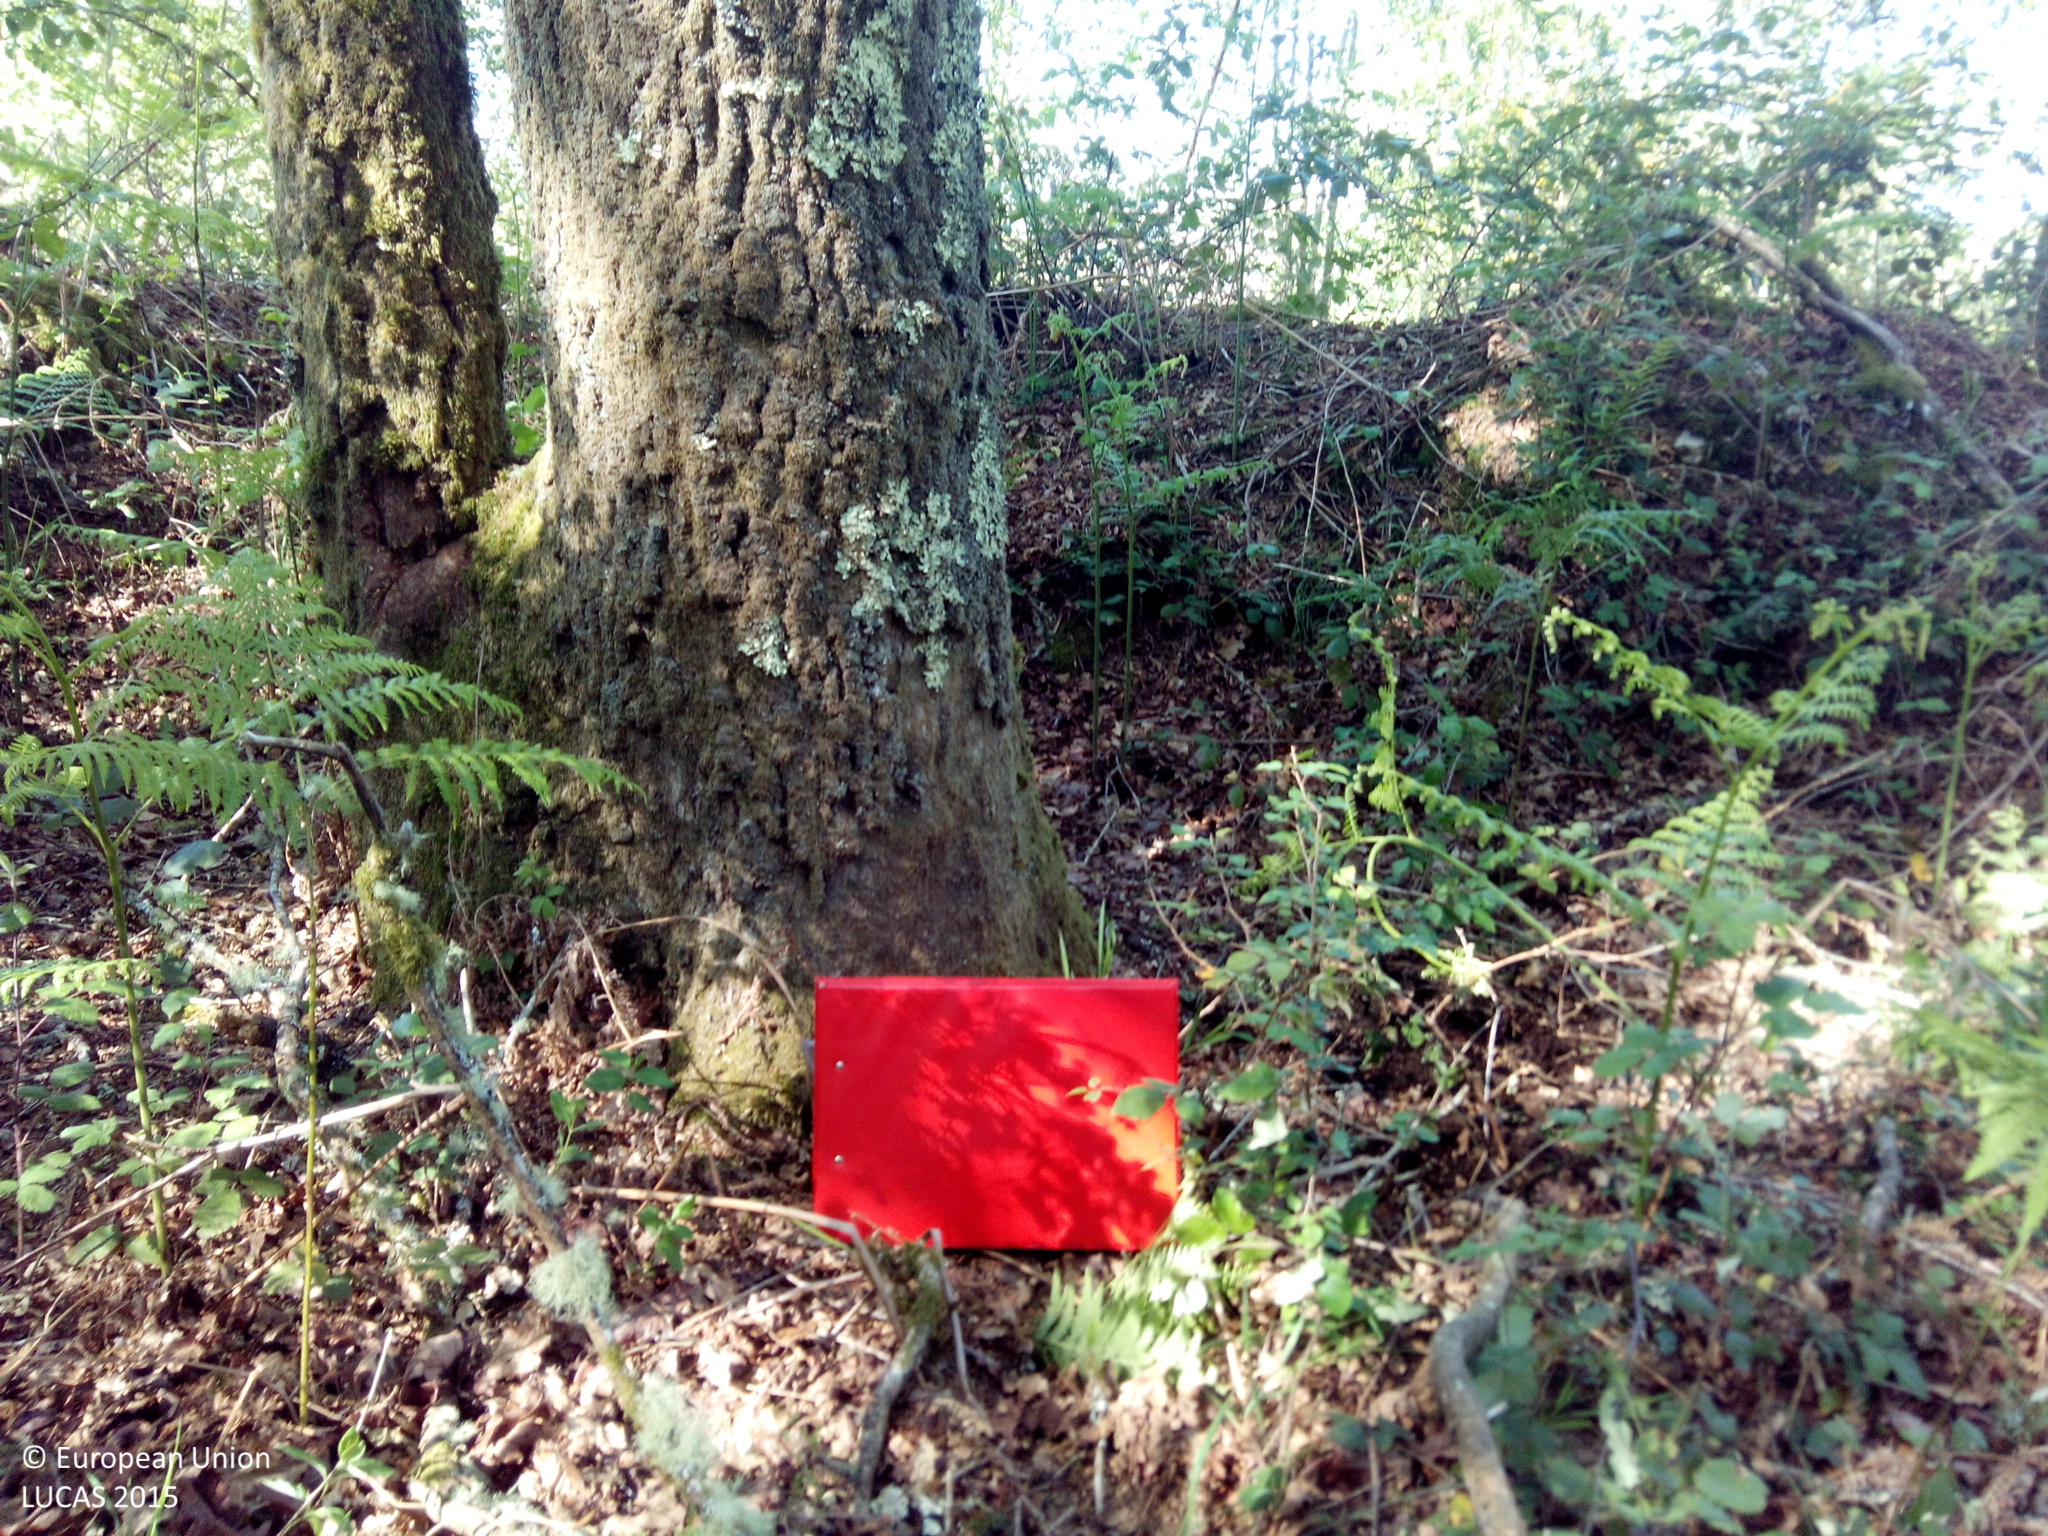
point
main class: Woodland
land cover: Broadleaved woodland
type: acidophilous oak and oak-birch forest
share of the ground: > 75 %
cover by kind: broadleaved forest trees 100 %
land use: Forestry
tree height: > 5 m
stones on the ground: 10 - 25 %
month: May
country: ES
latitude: 42.6364
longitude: -8.3767
